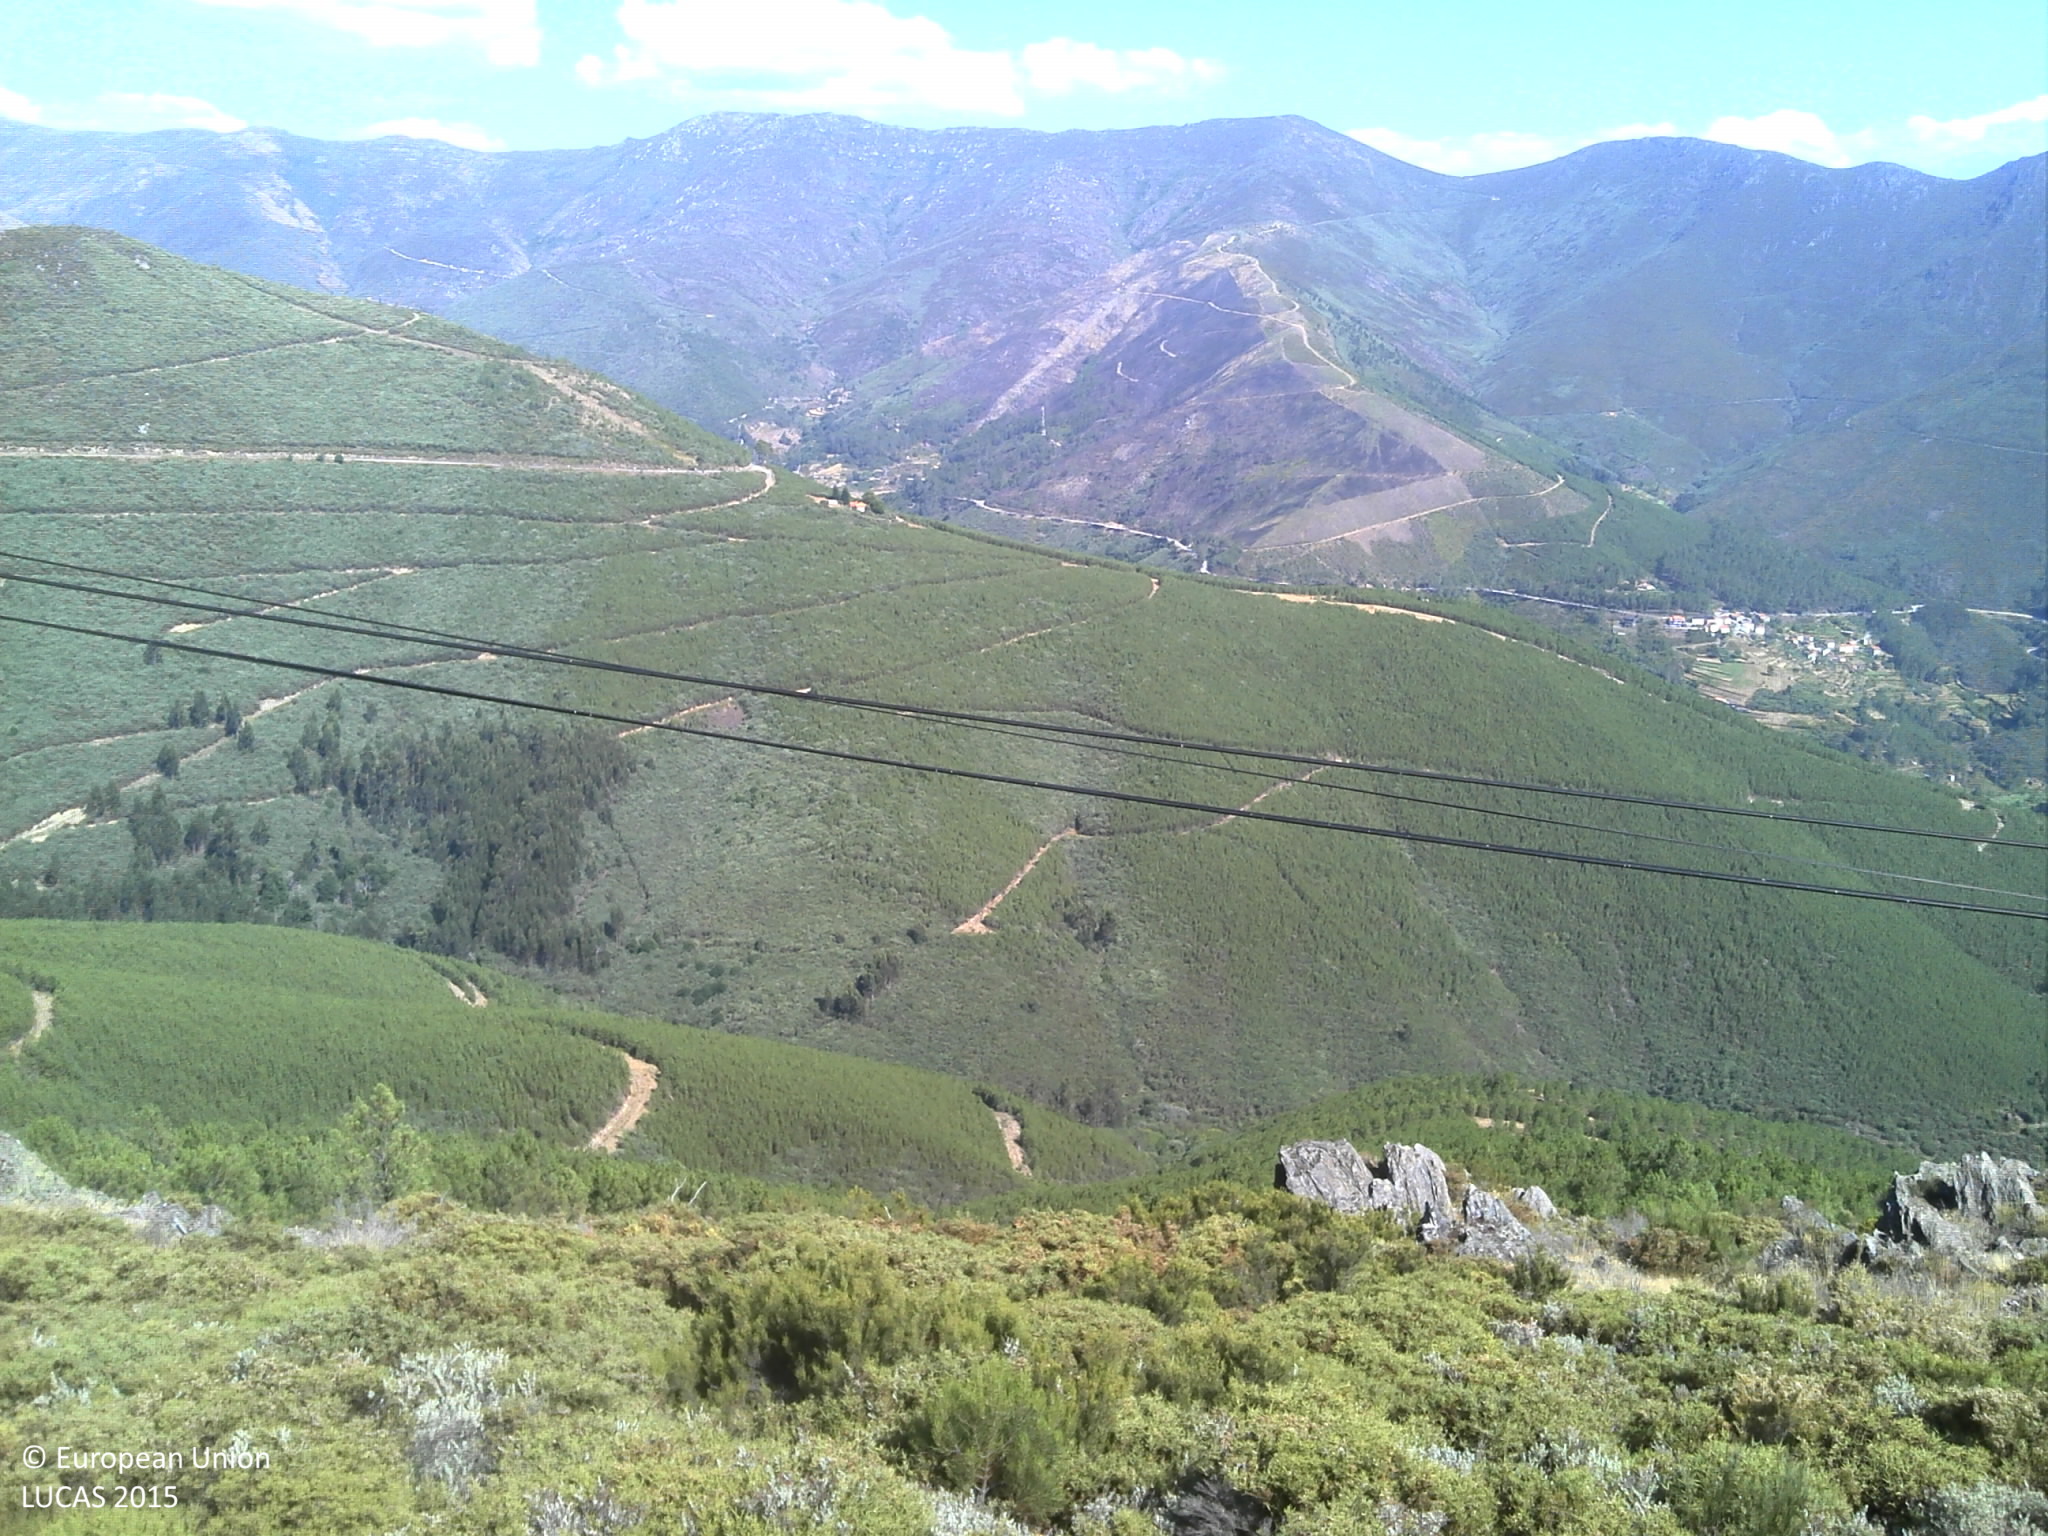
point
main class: Shrubland
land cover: Shrubland without tree cover
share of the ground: > 75 %
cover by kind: shrubs 75 %, unconsolidated bare surface 25 %
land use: Semi-natural and natural areas not in use
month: July
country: PT
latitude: 40.3049
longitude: -7.7026
